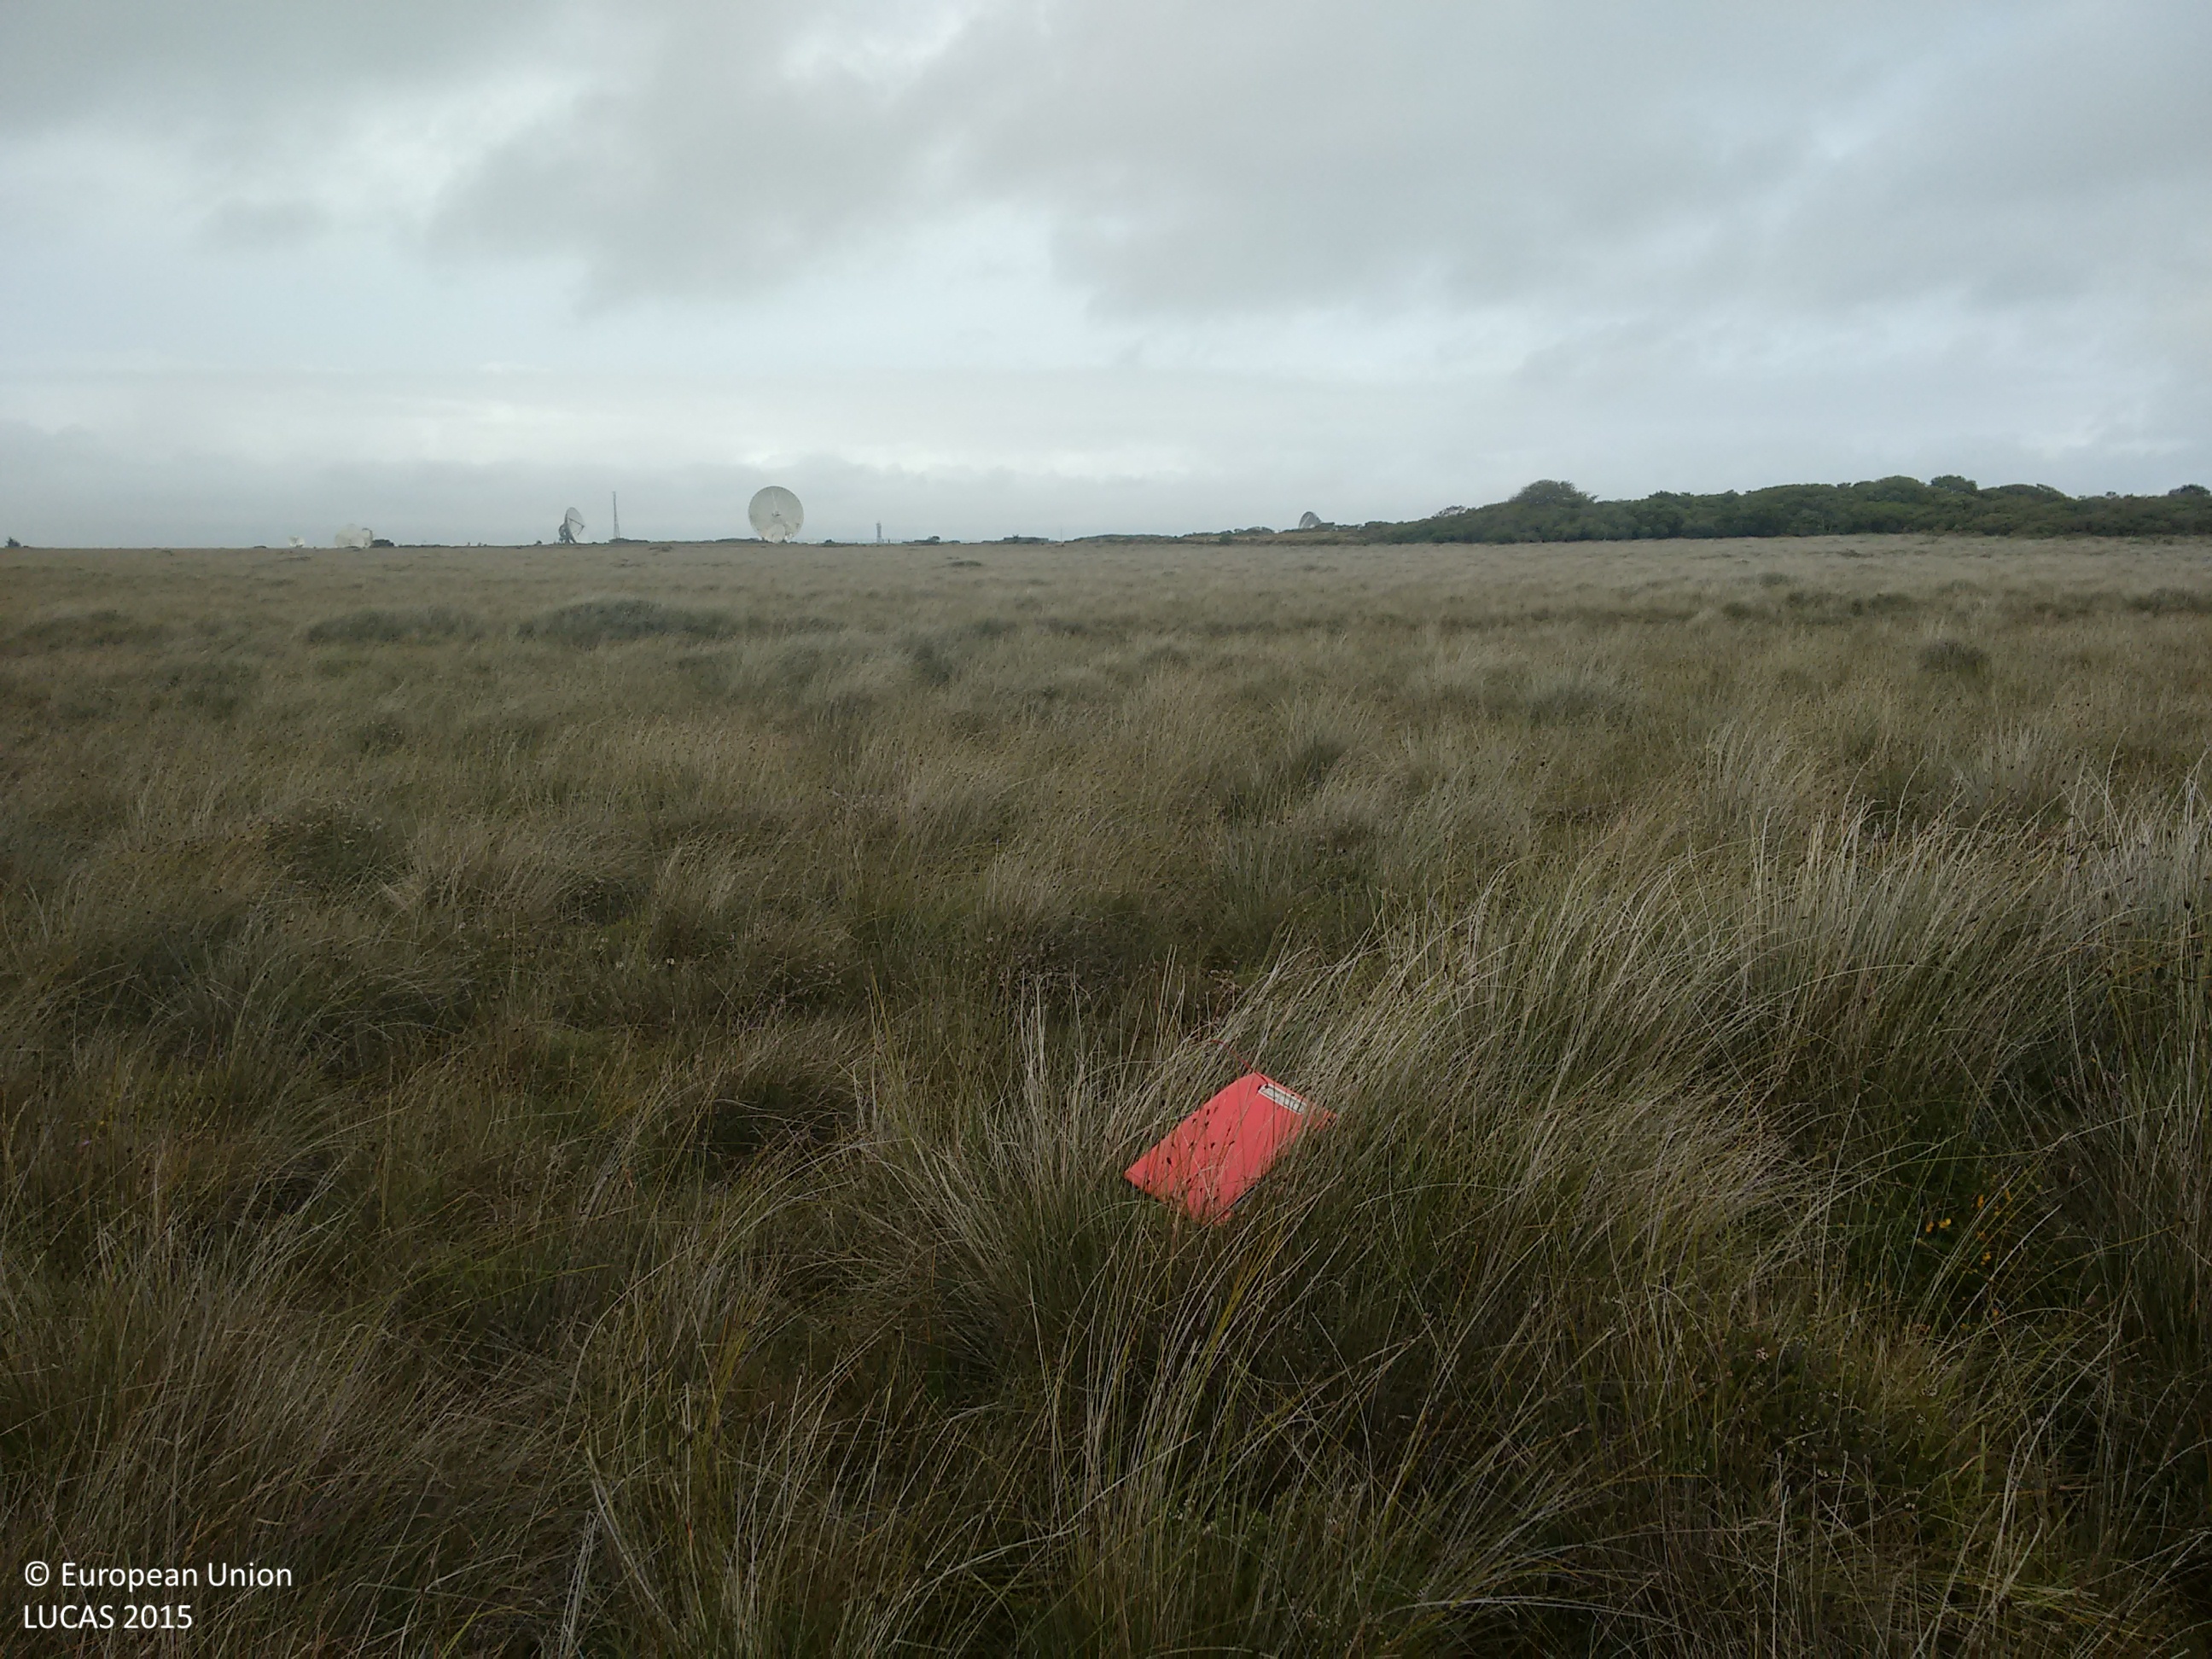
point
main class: Grassland
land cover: Grassland without tree/shrub cover
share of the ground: > 75 %
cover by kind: herbaceous plants 100 %
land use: Agriculture (excluding fallow land and kitchen gardens)
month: August
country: GB
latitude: 50.0378
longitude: -5.1846
